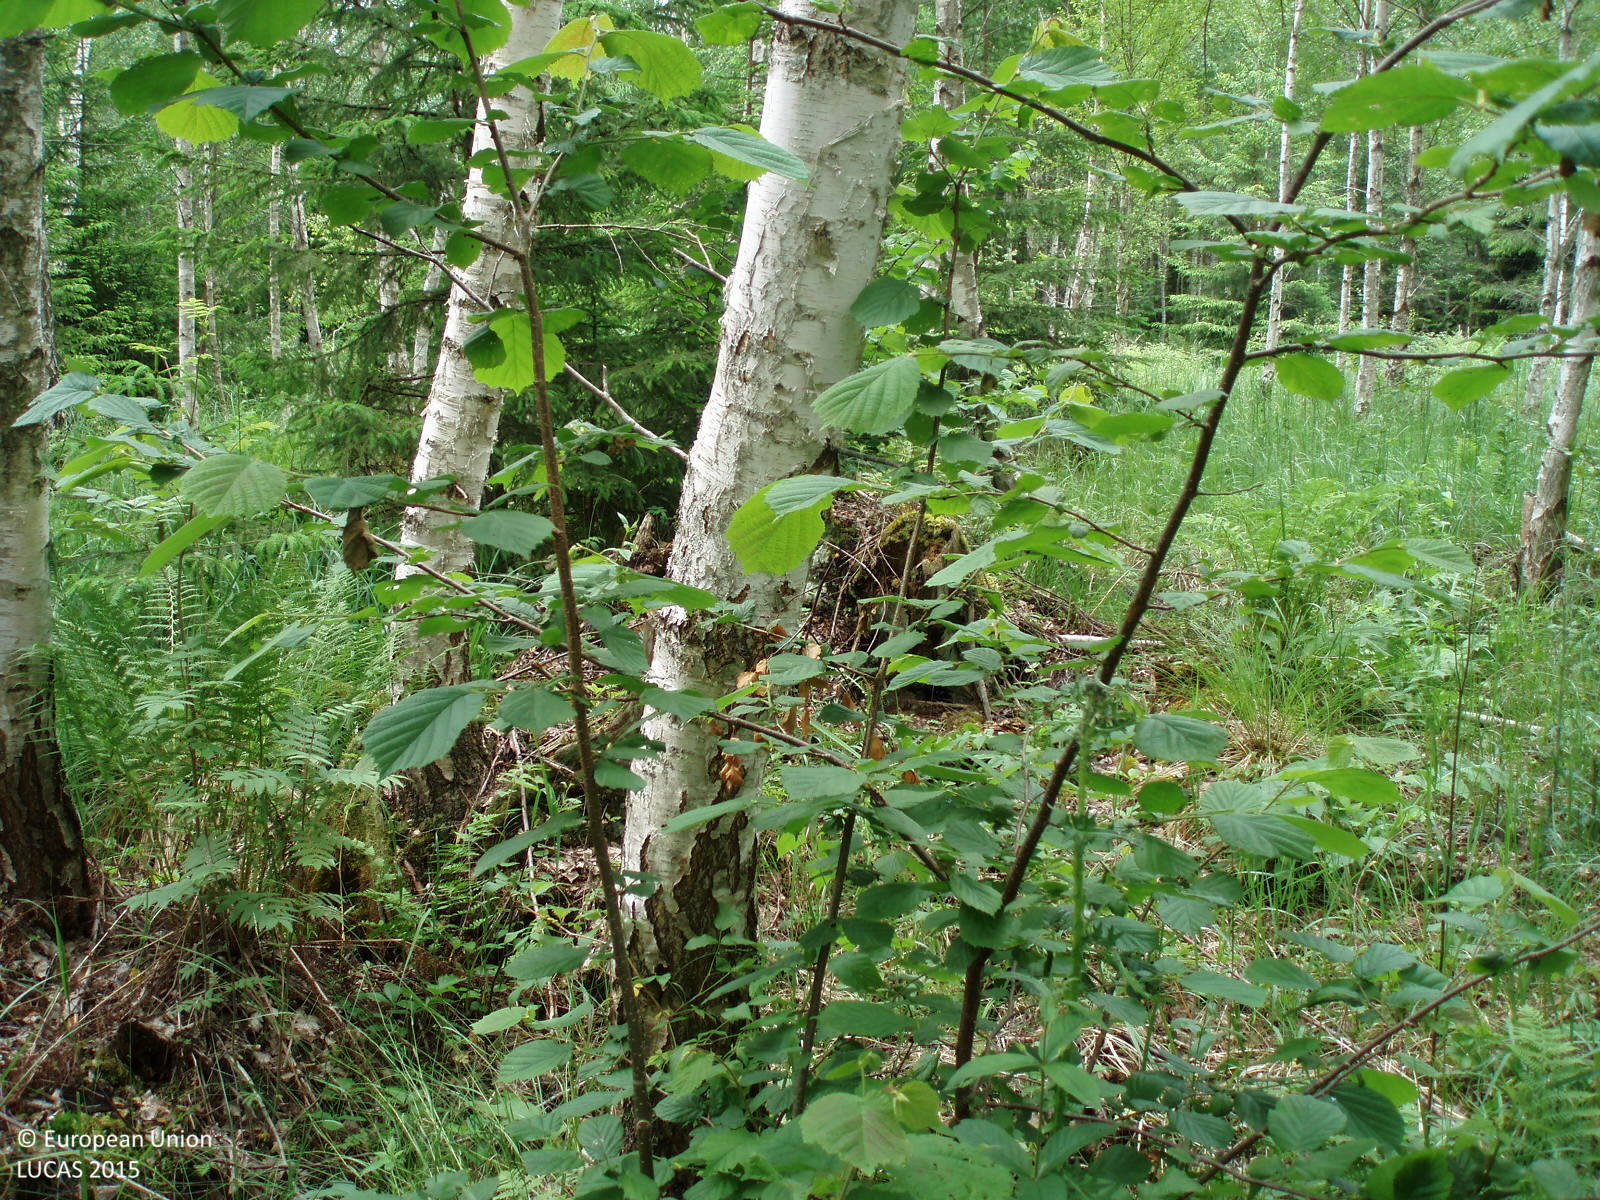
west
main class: Woodland
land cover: Broadleaved woodland
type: acidophilous oak and oak-birch forest
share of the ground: 50 - 75 %
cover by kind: broadleaved forest trees 65 %, herbaceous plants 30 %, coniferous forest trees 5 %
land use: Forestry
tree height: > 5 m
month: June
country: LT
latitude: 56.2176
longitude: 22.9833
